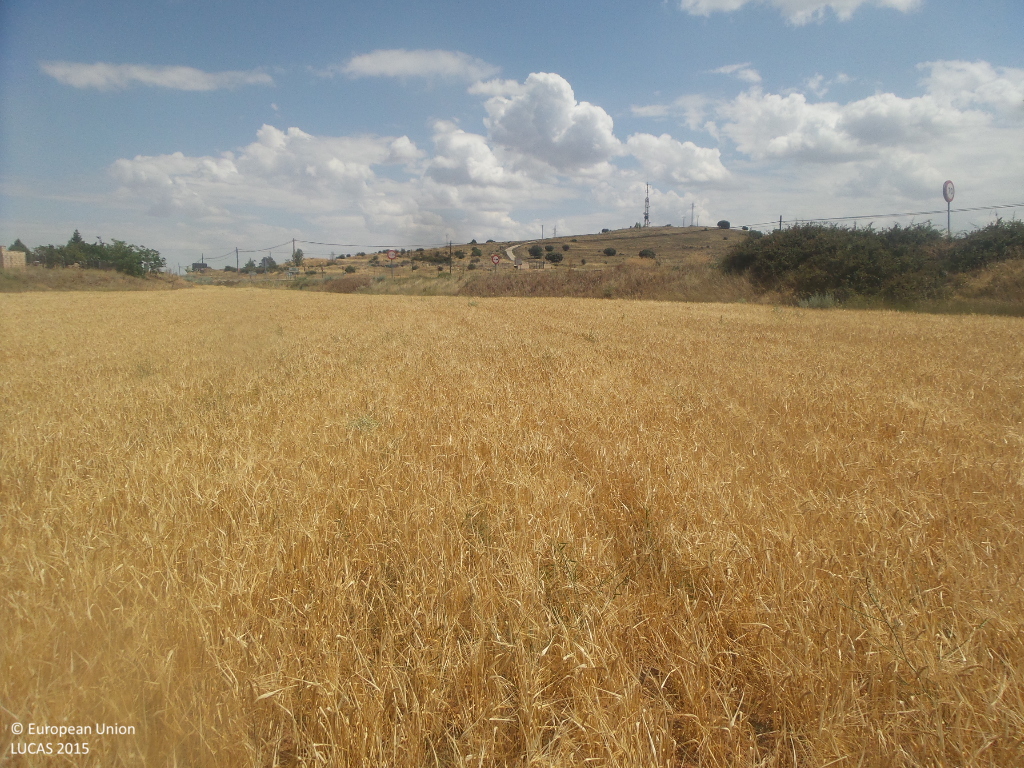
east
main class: Cropland
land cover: Barley
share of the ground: > 75 %
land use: Agriculture (excluding fallow land and kitchen gardens)
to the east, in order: Barley; Shrubland without tree cover; Tracks; Paved roads, cycling and walking lanes; Grass margins; Common wheat; Electric lines; Common wheat; Shrubland without tree cover; Barley; Grass margins; Fences; Artificial constructions in urban areas
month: July
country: ES
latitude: 41.0530
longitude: -2.6562
